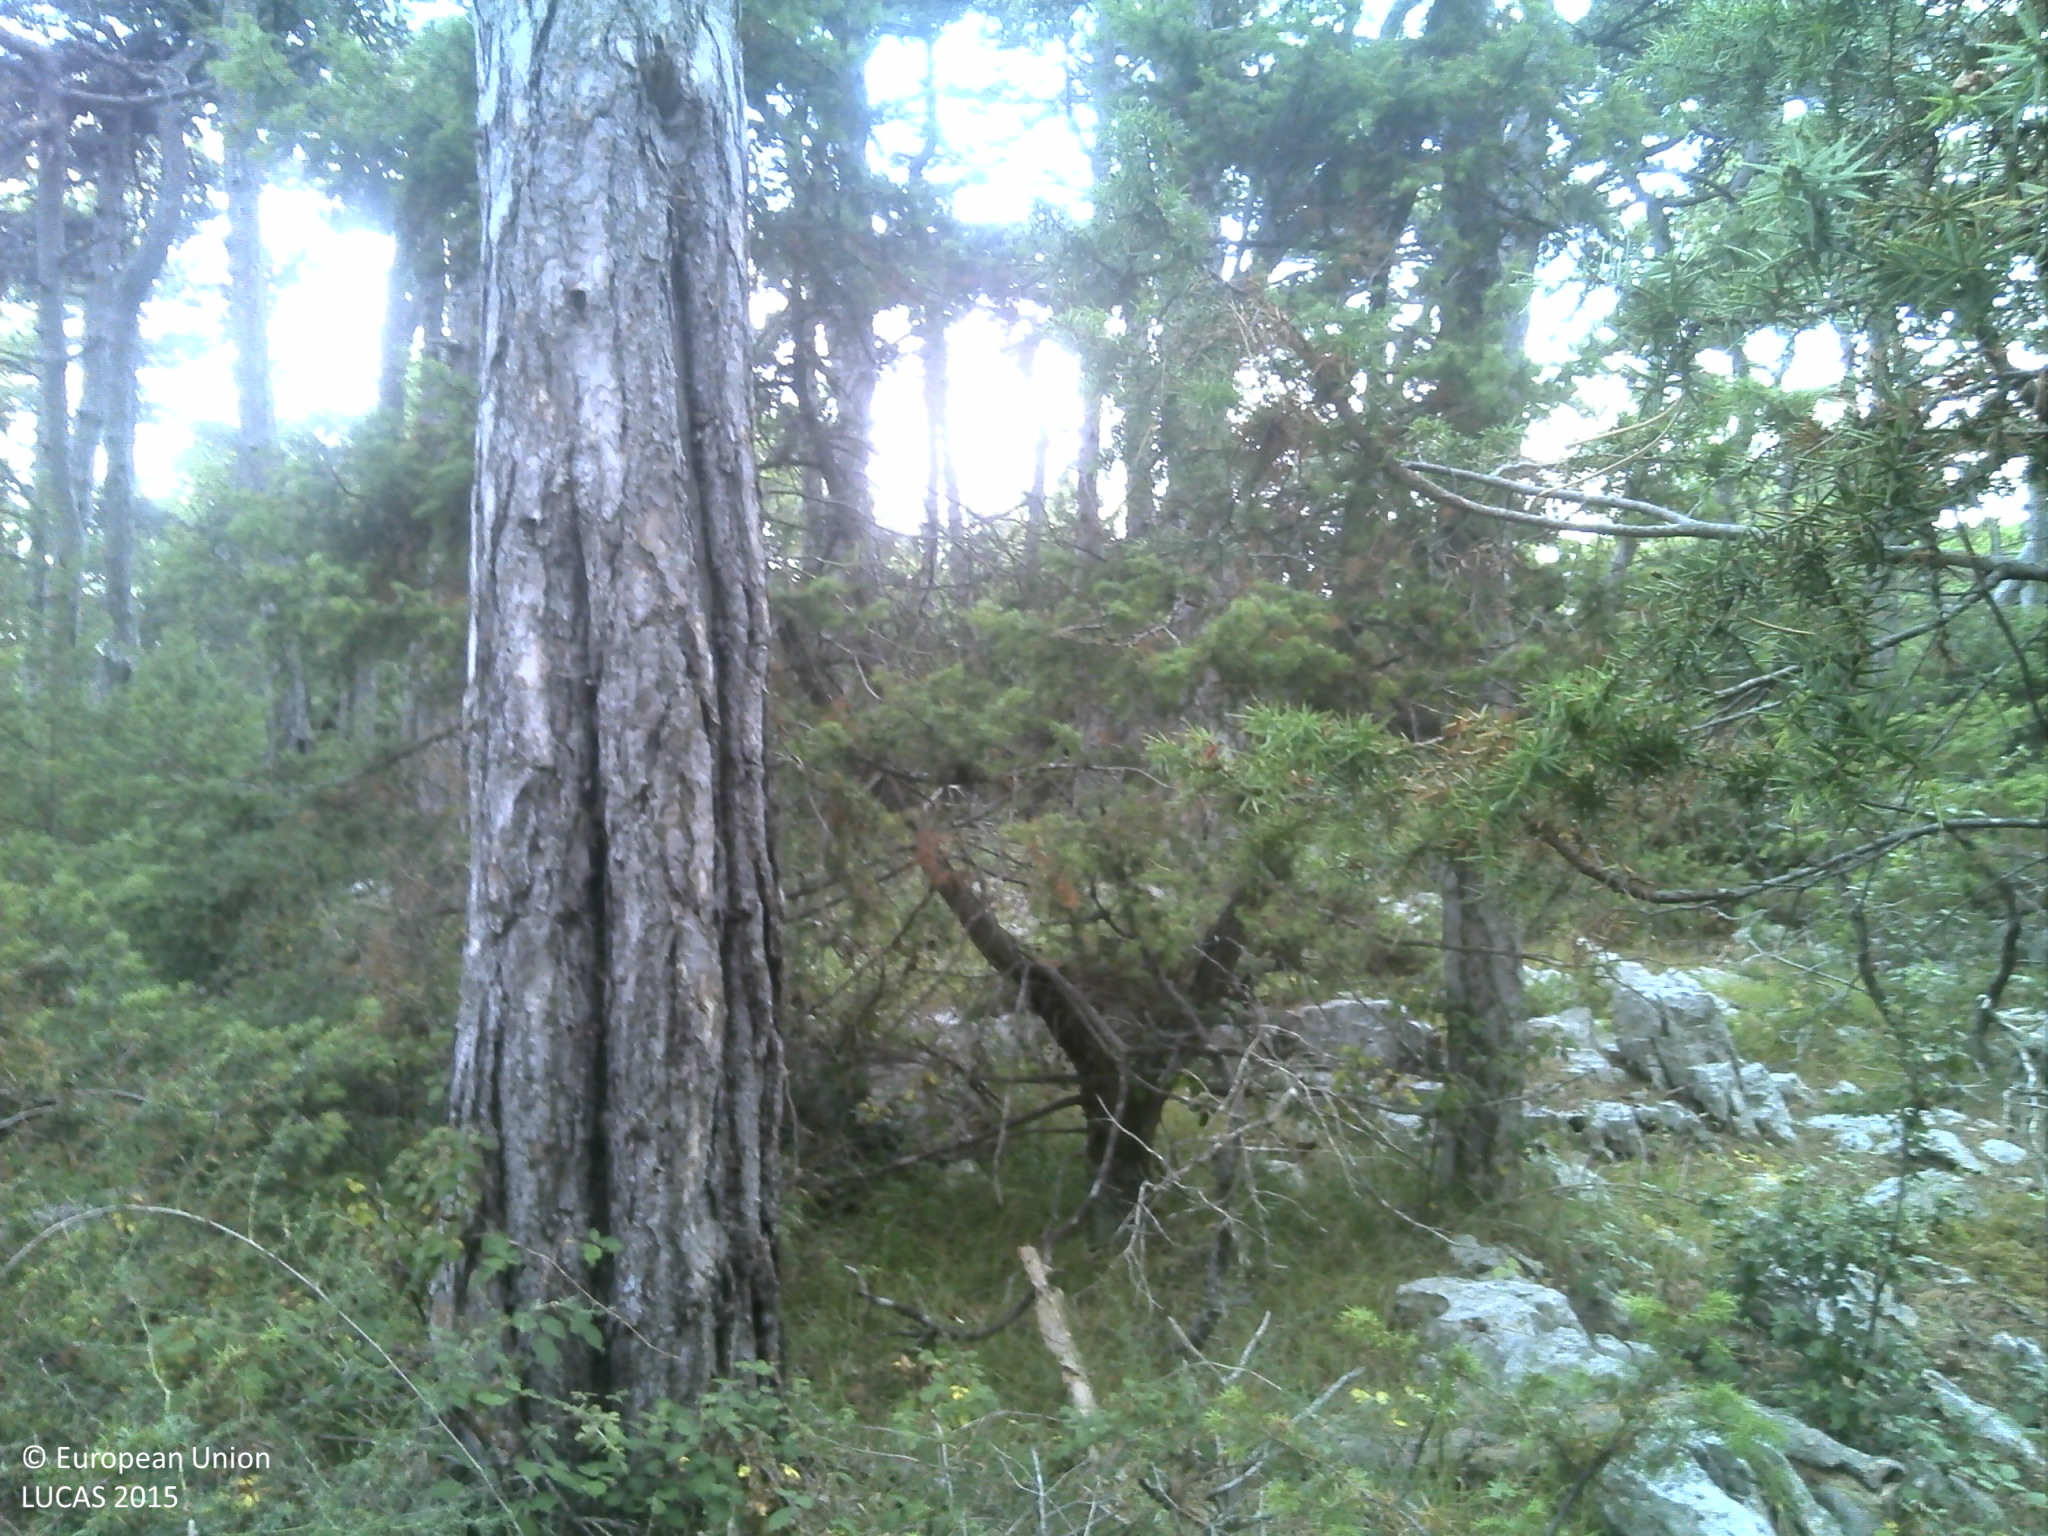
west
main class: Woodland
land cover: Pine dominated coniferous woodland
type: coniferous forest of the mediterranean region
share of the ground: > 75 %
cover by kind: coniferous forest trees 75 %, shrubs 15 %, herbaceous plants 5 %, consolidated bare surface 5 %
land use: Semi-natural and natural areas not in use
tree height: > 5 m
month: July
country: HR
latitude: 43.2908
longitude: 16.5839
